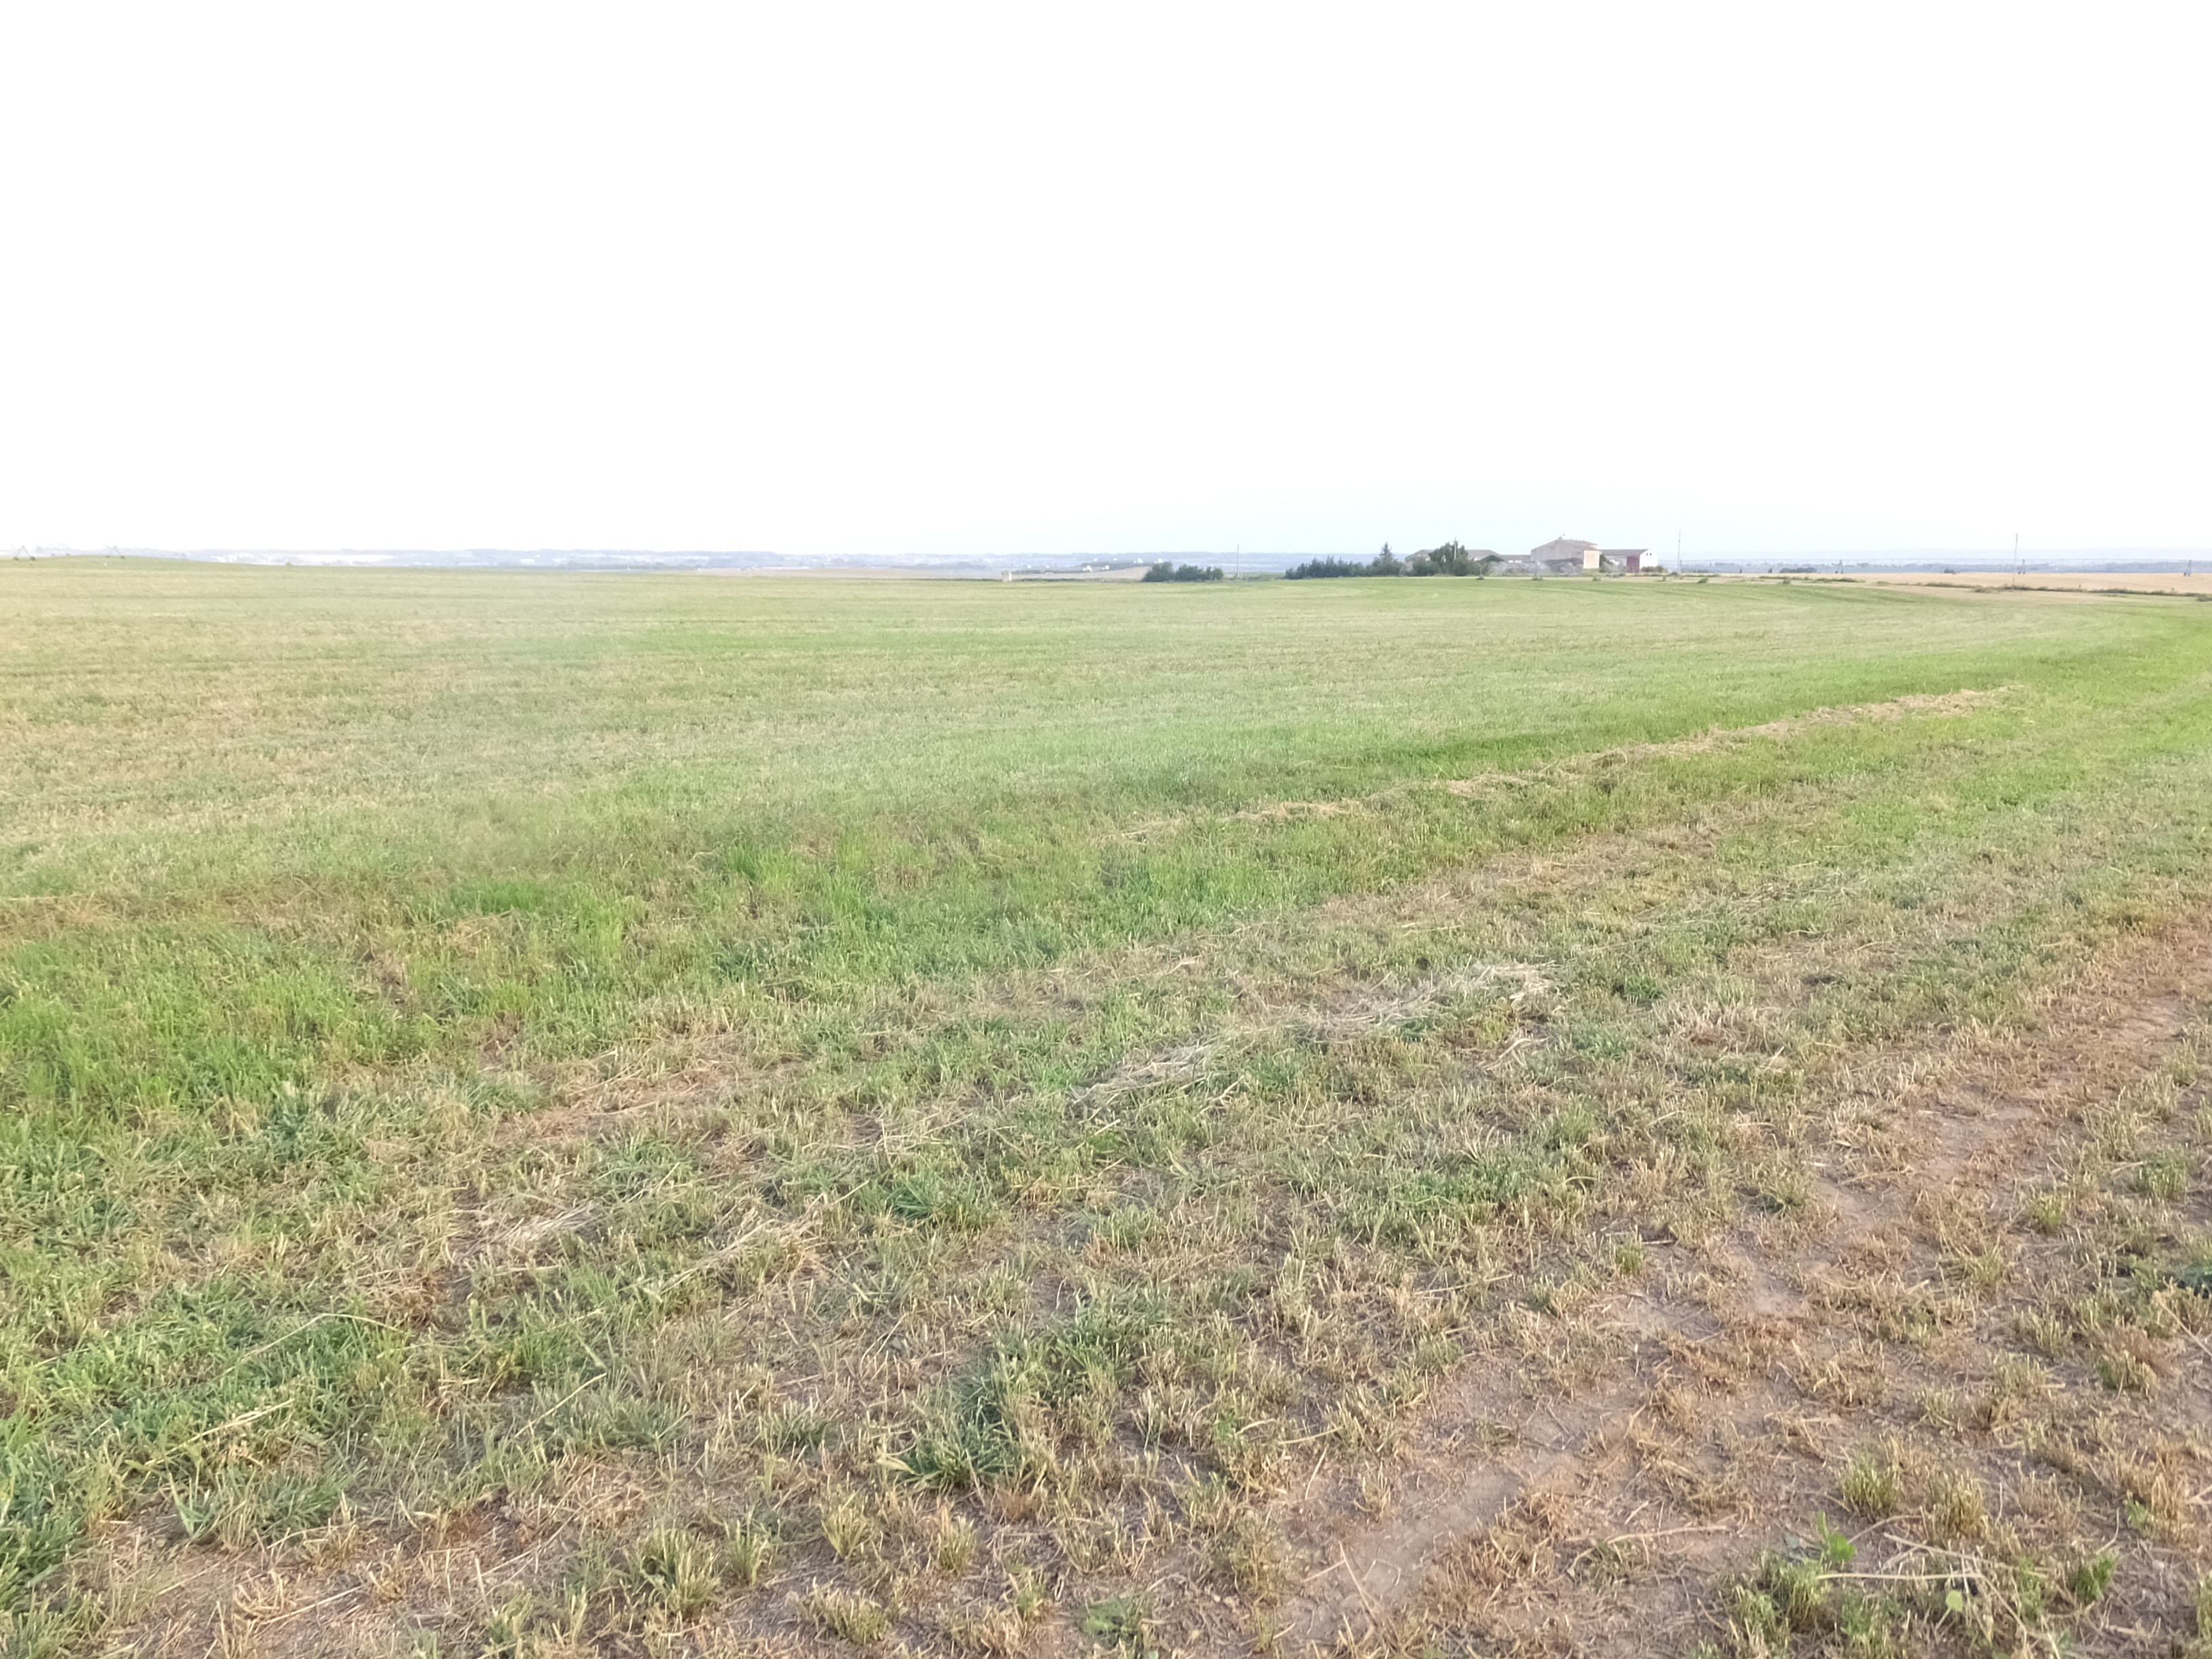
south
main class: Cropland
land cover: Lucerne
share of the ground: > 75 %
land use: Agriculture (excluding fallow land and kitchen gardens)
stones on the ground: < 10 %
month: July
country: ES
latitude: 41.7561
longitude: 0.3516
